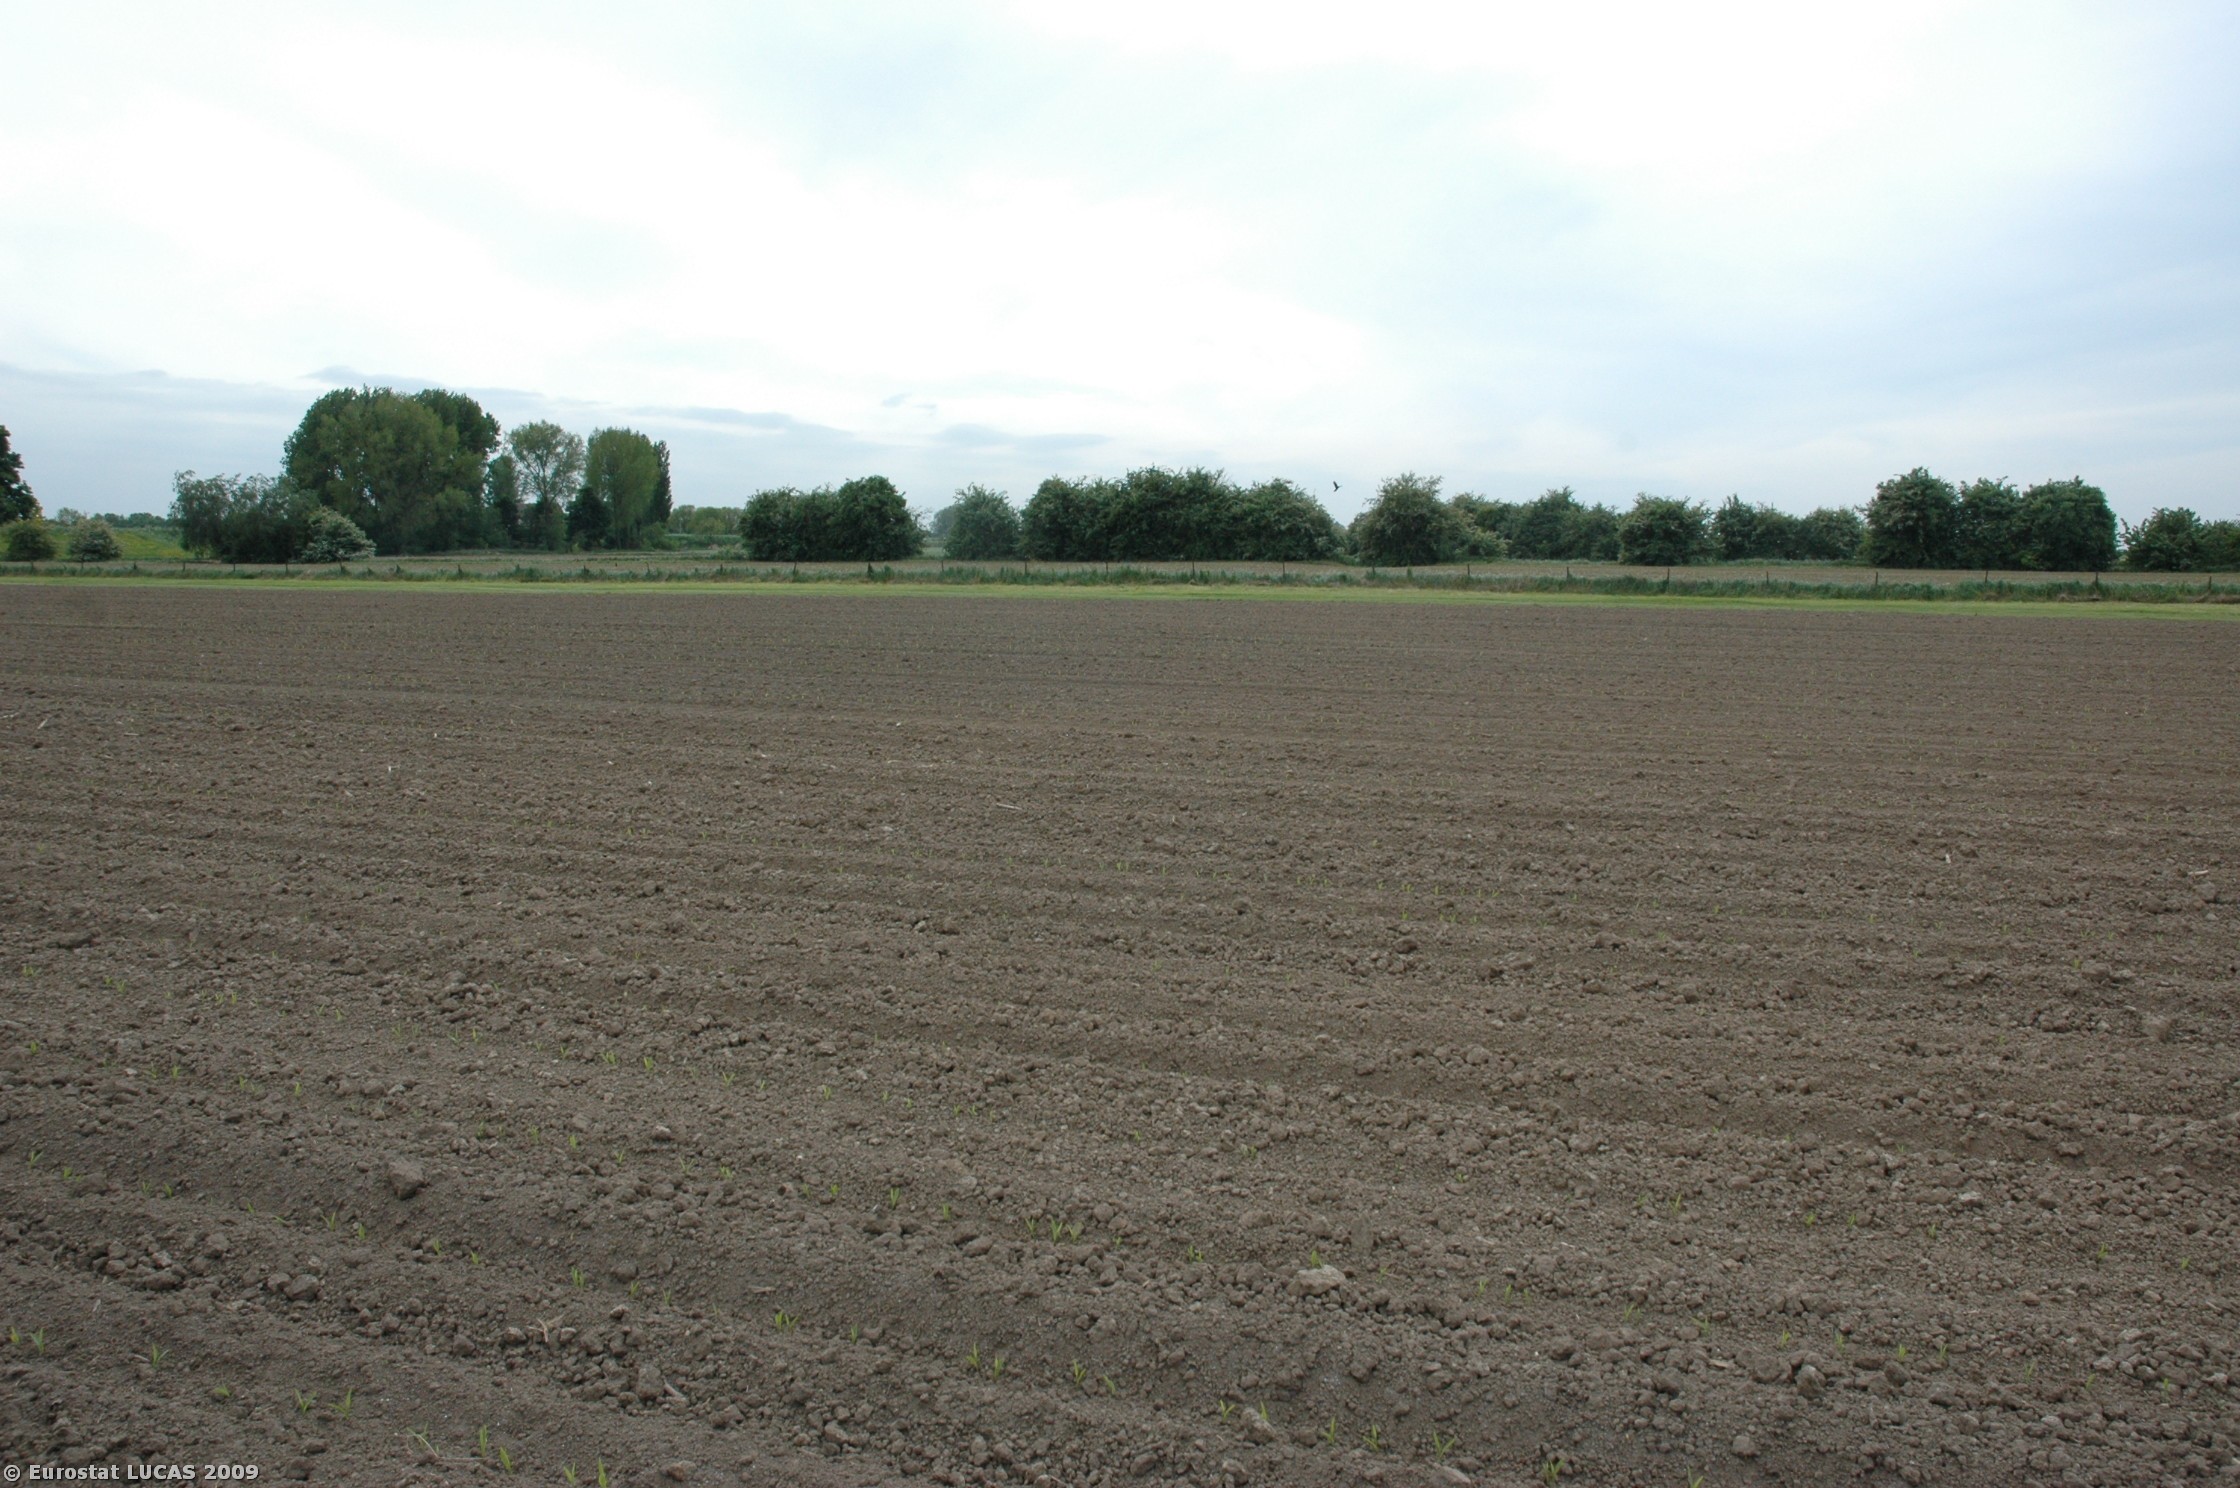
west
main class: Grassland
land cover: Grassland without tree/shrub cover
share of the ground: > 75 %
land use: Agriculture (excluding fallow land and kitchen gardens)
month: May
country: NL
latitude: 51.9626
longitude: 5.3554
